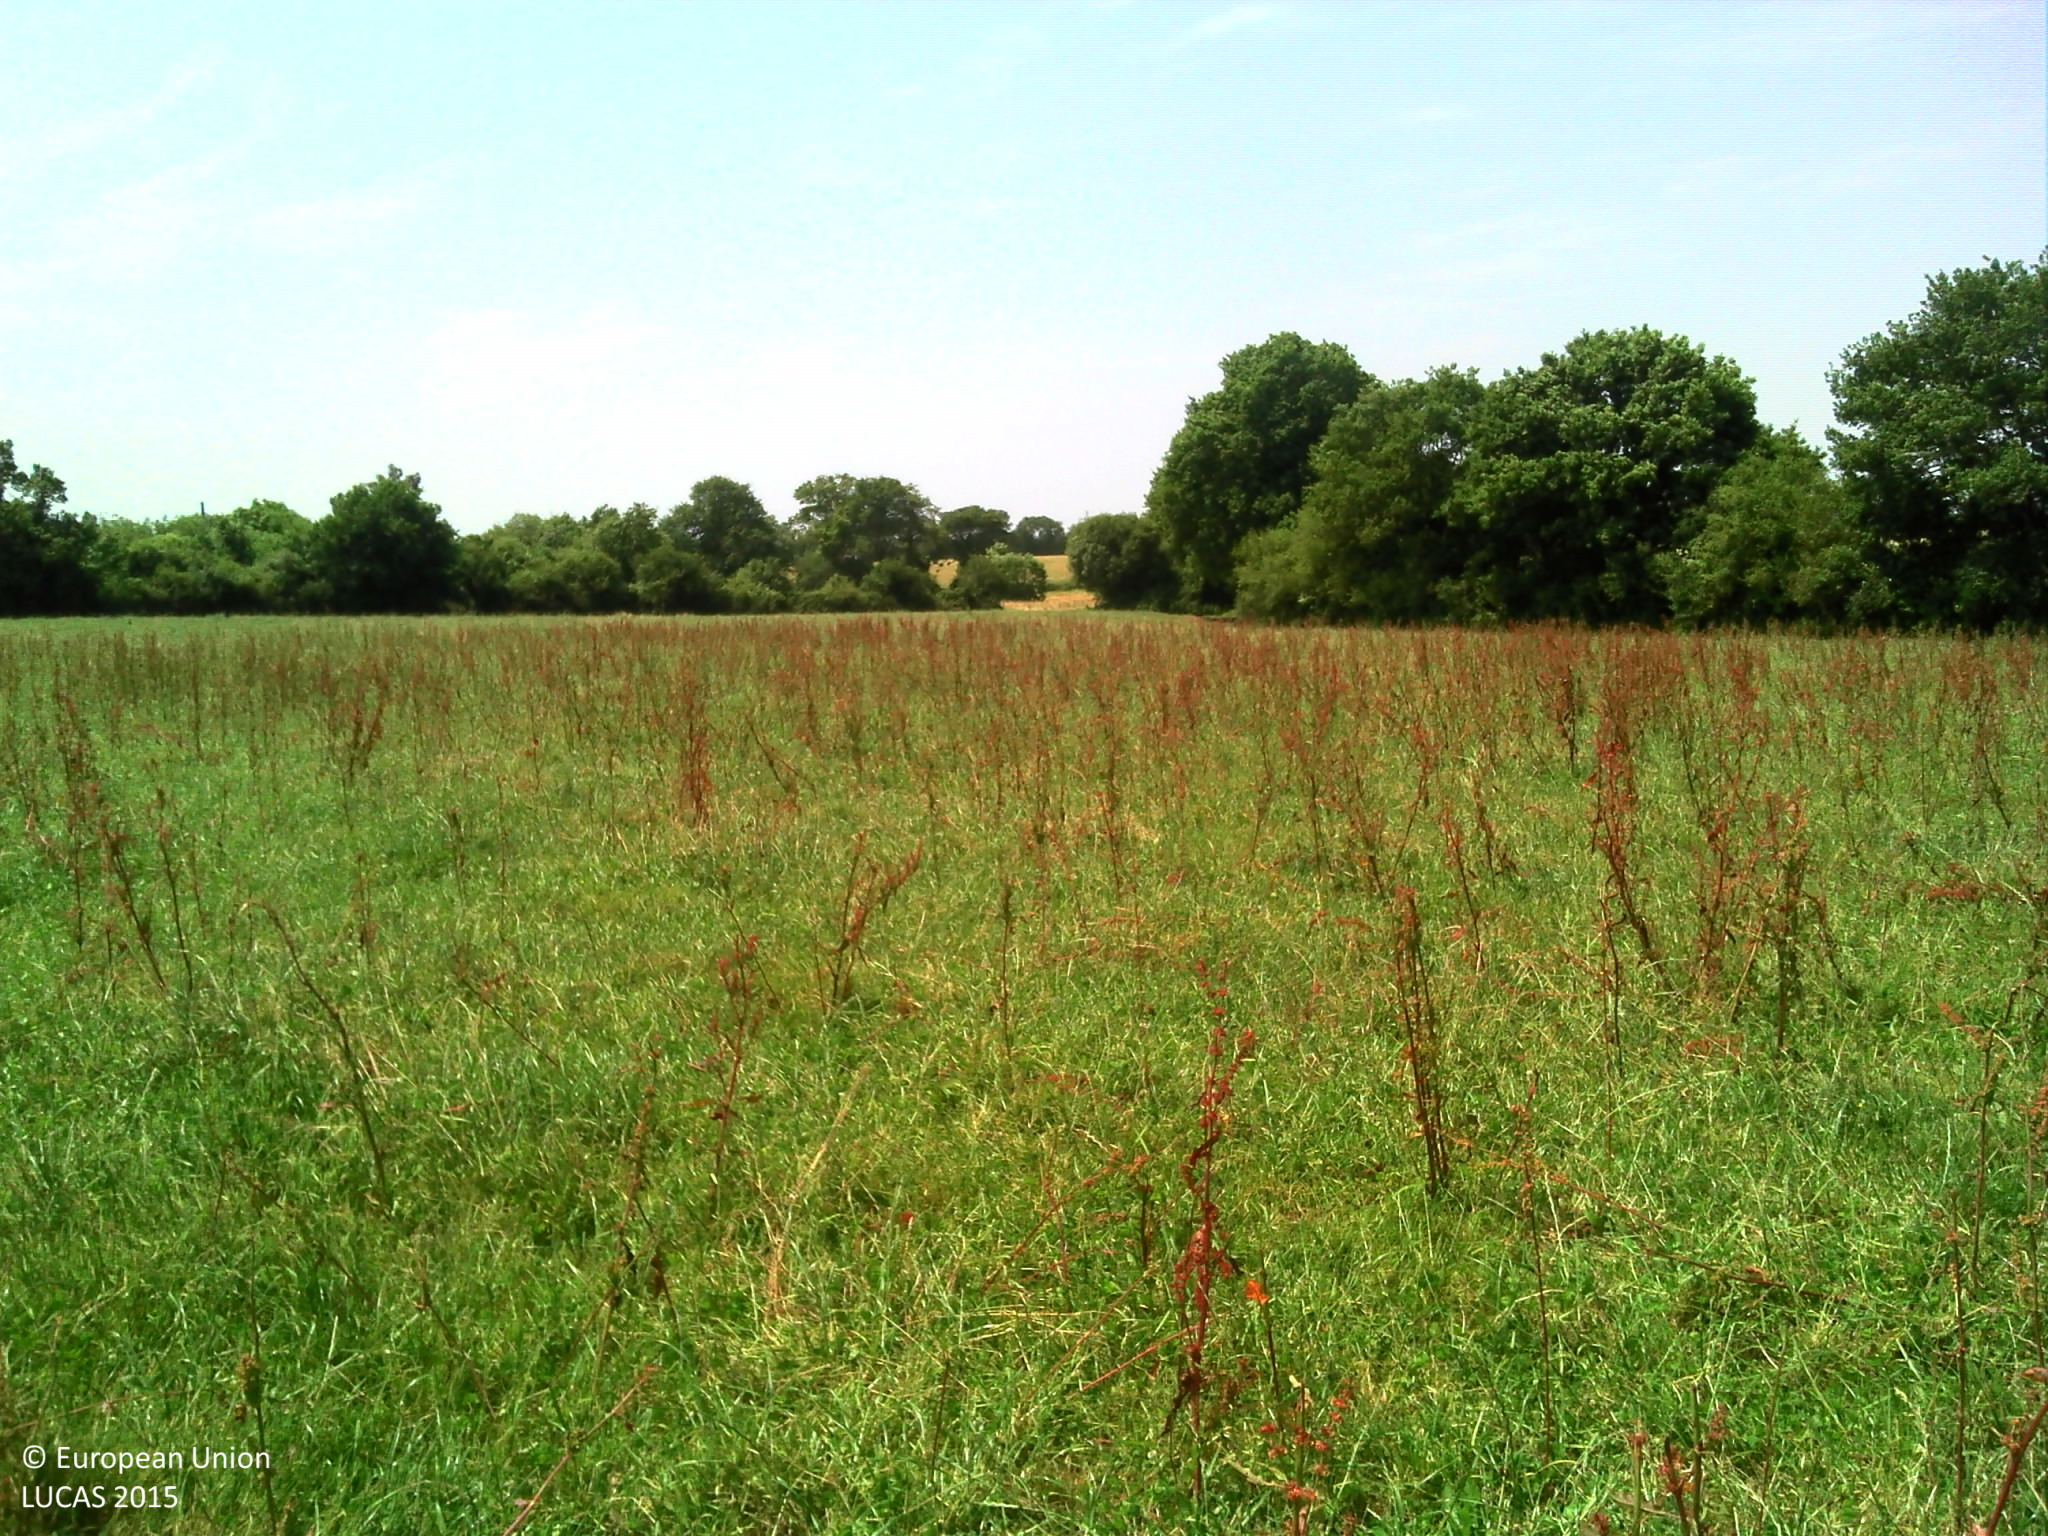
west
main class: Grassland
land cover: Grassland without tree/shrub cover
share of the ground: > 75 %
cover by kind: herbaceous plants 100 %
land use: Agriculture (excluding fallow land and kitchen gardens)
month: June
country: FR
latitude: 46.8169
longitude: -1.6936
